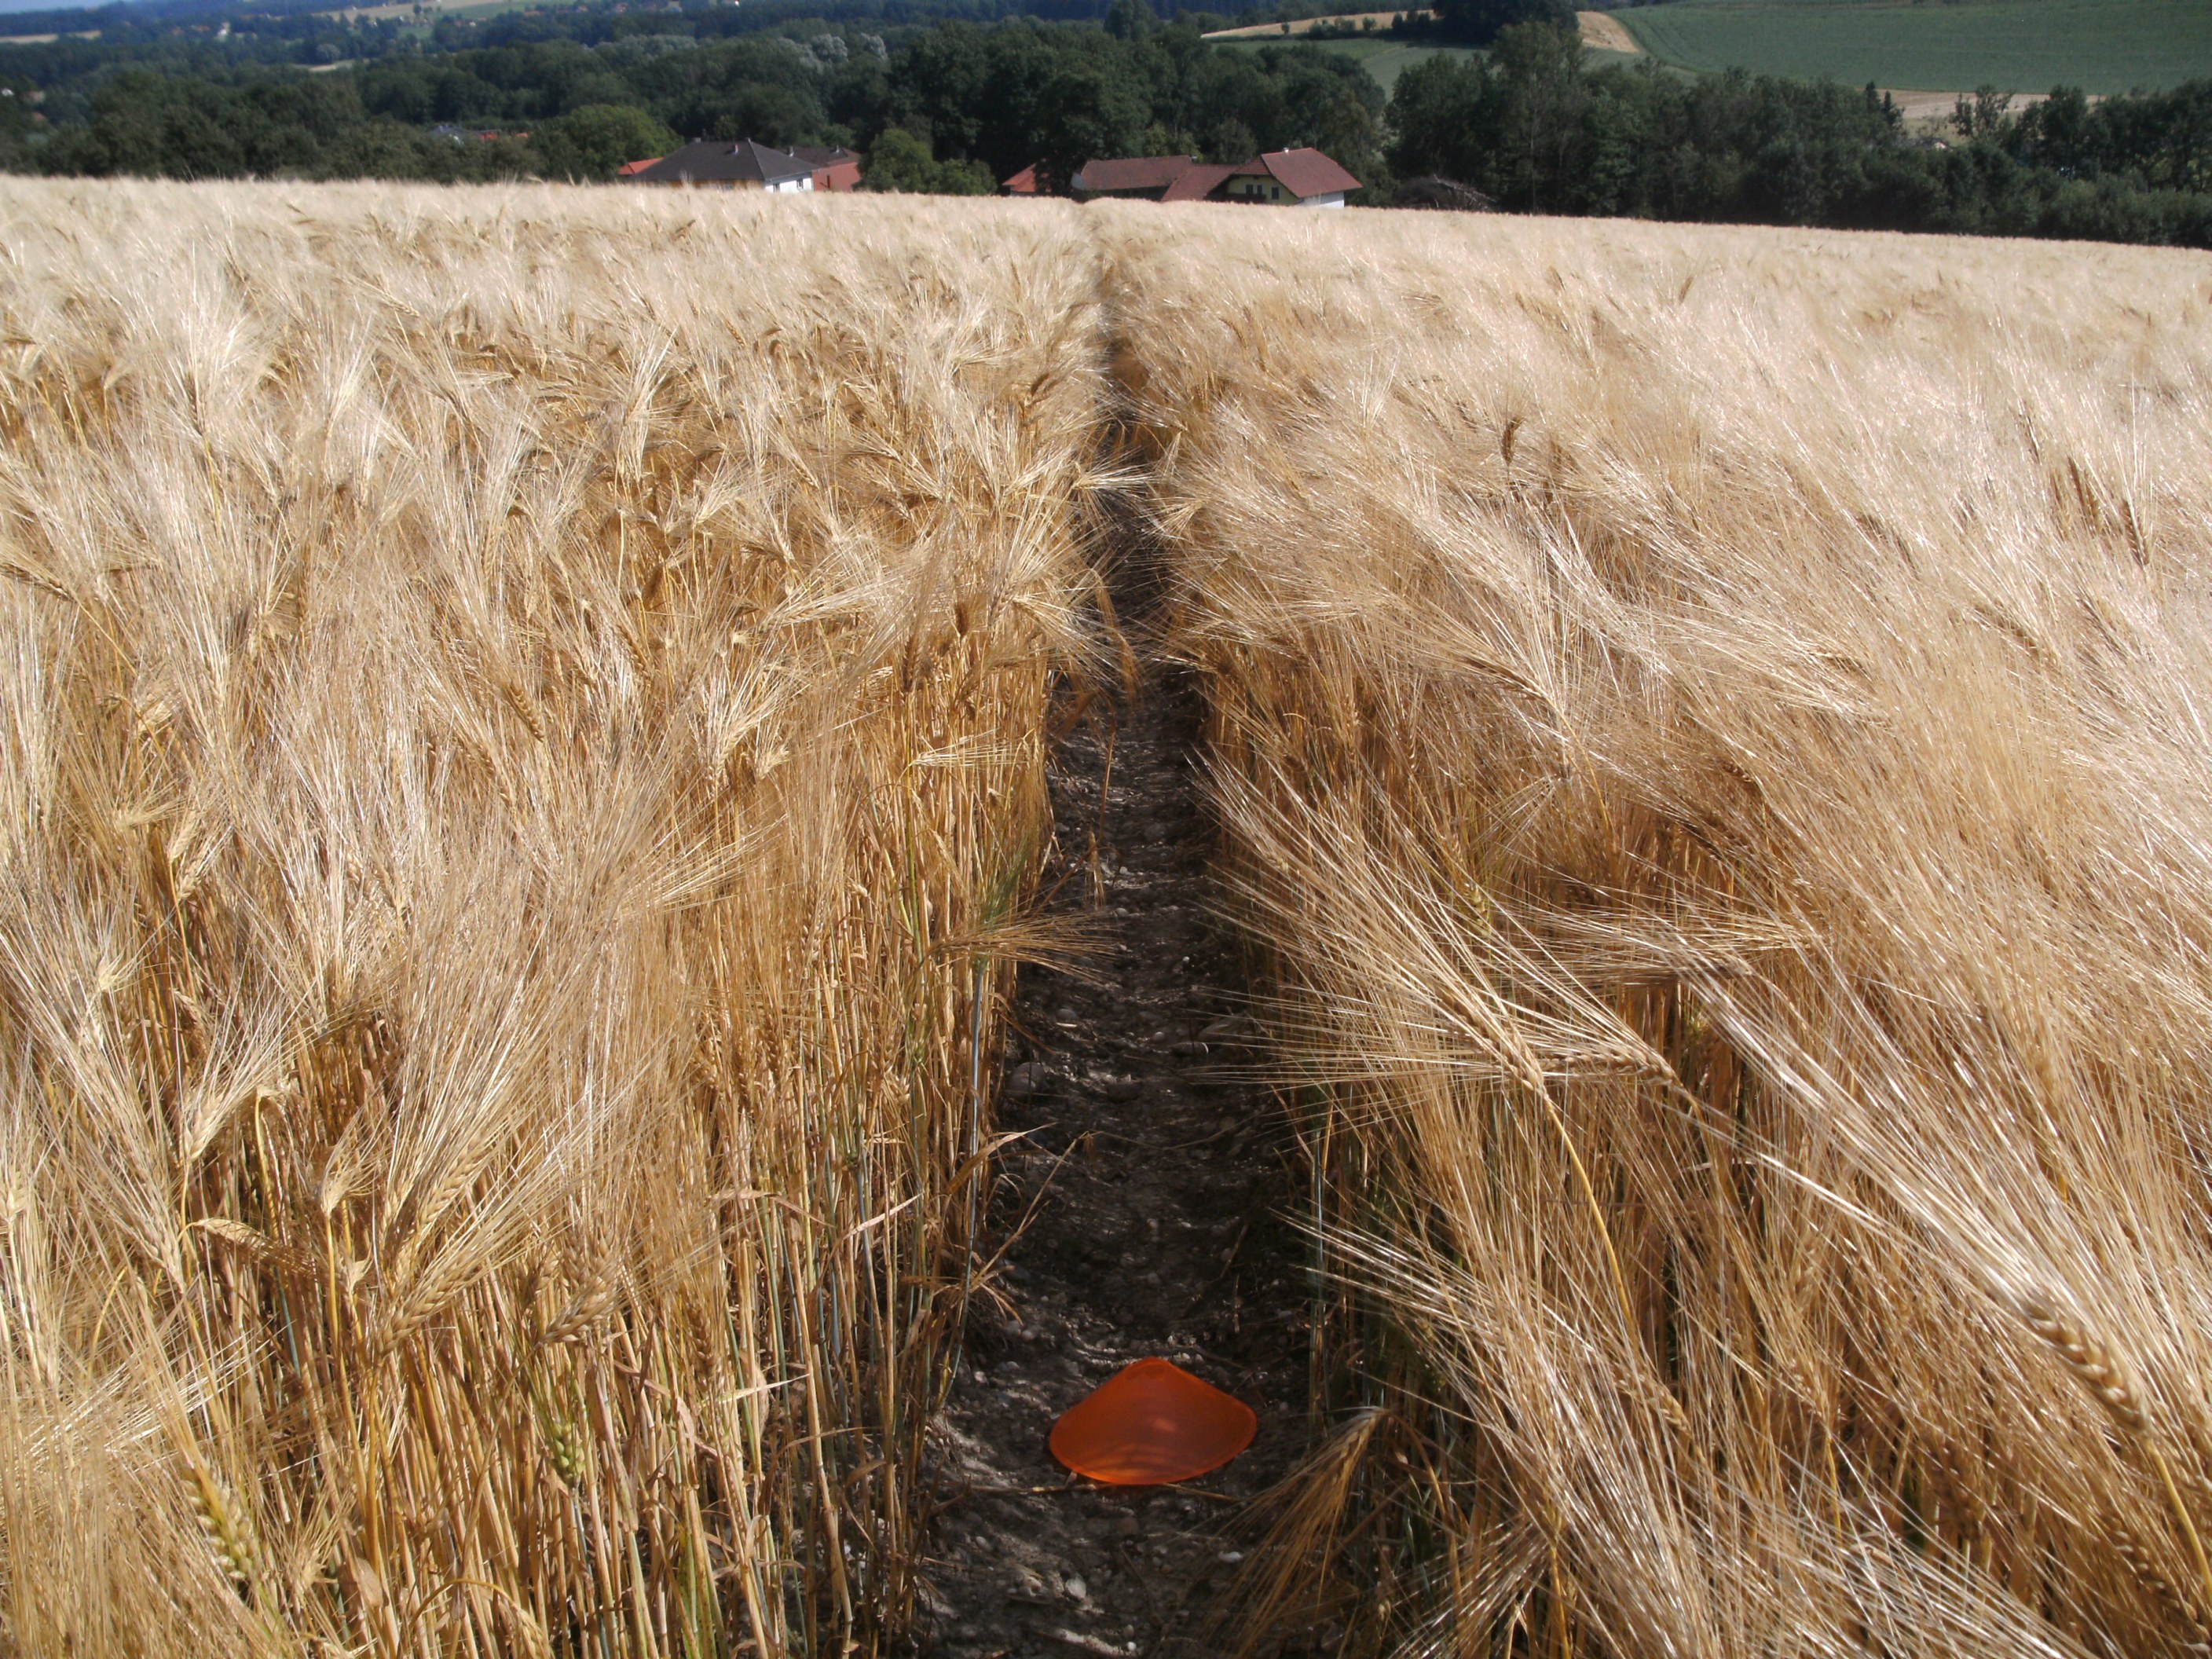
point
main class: Cropland
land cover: Barley
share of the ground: > 75 %
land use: Agriculture (excluding fallow land and kitchen gardens)
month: June
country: AT
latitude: 48.2505
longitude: 13.7301
